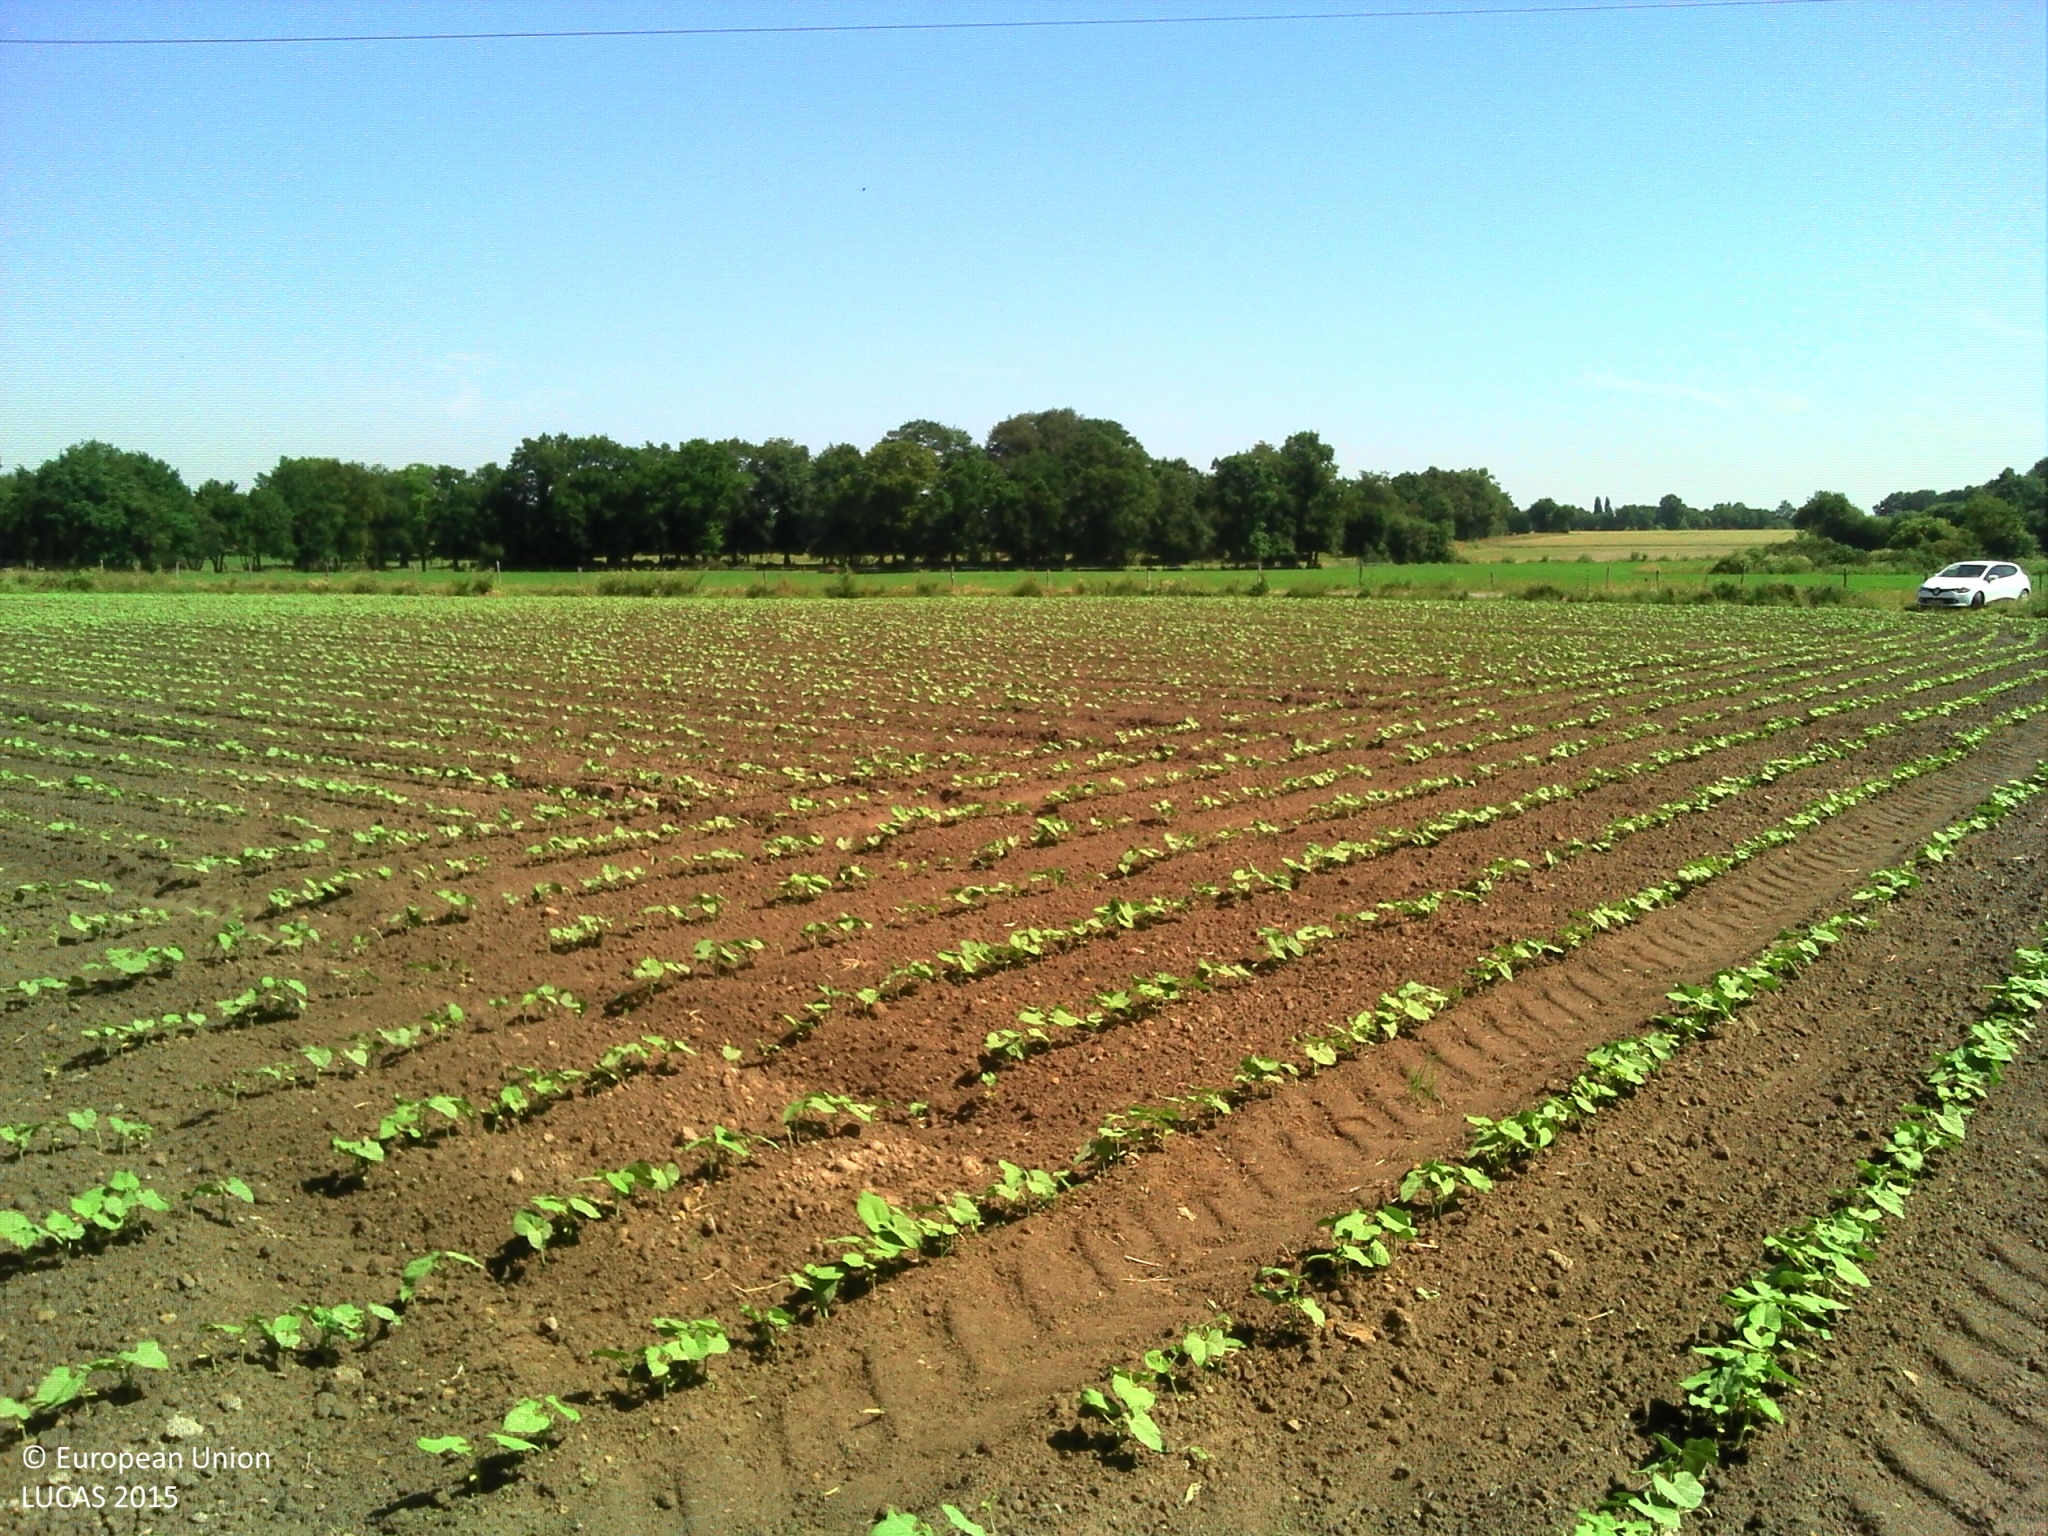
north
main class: Cropland
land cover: Dry pulses
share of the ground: 10 - 25 %
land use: Agriculture (excluding fallow land and kitchen gardens)
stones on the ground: < 10 %
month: June
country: FR
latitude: 46.7916
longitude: -1.4226
